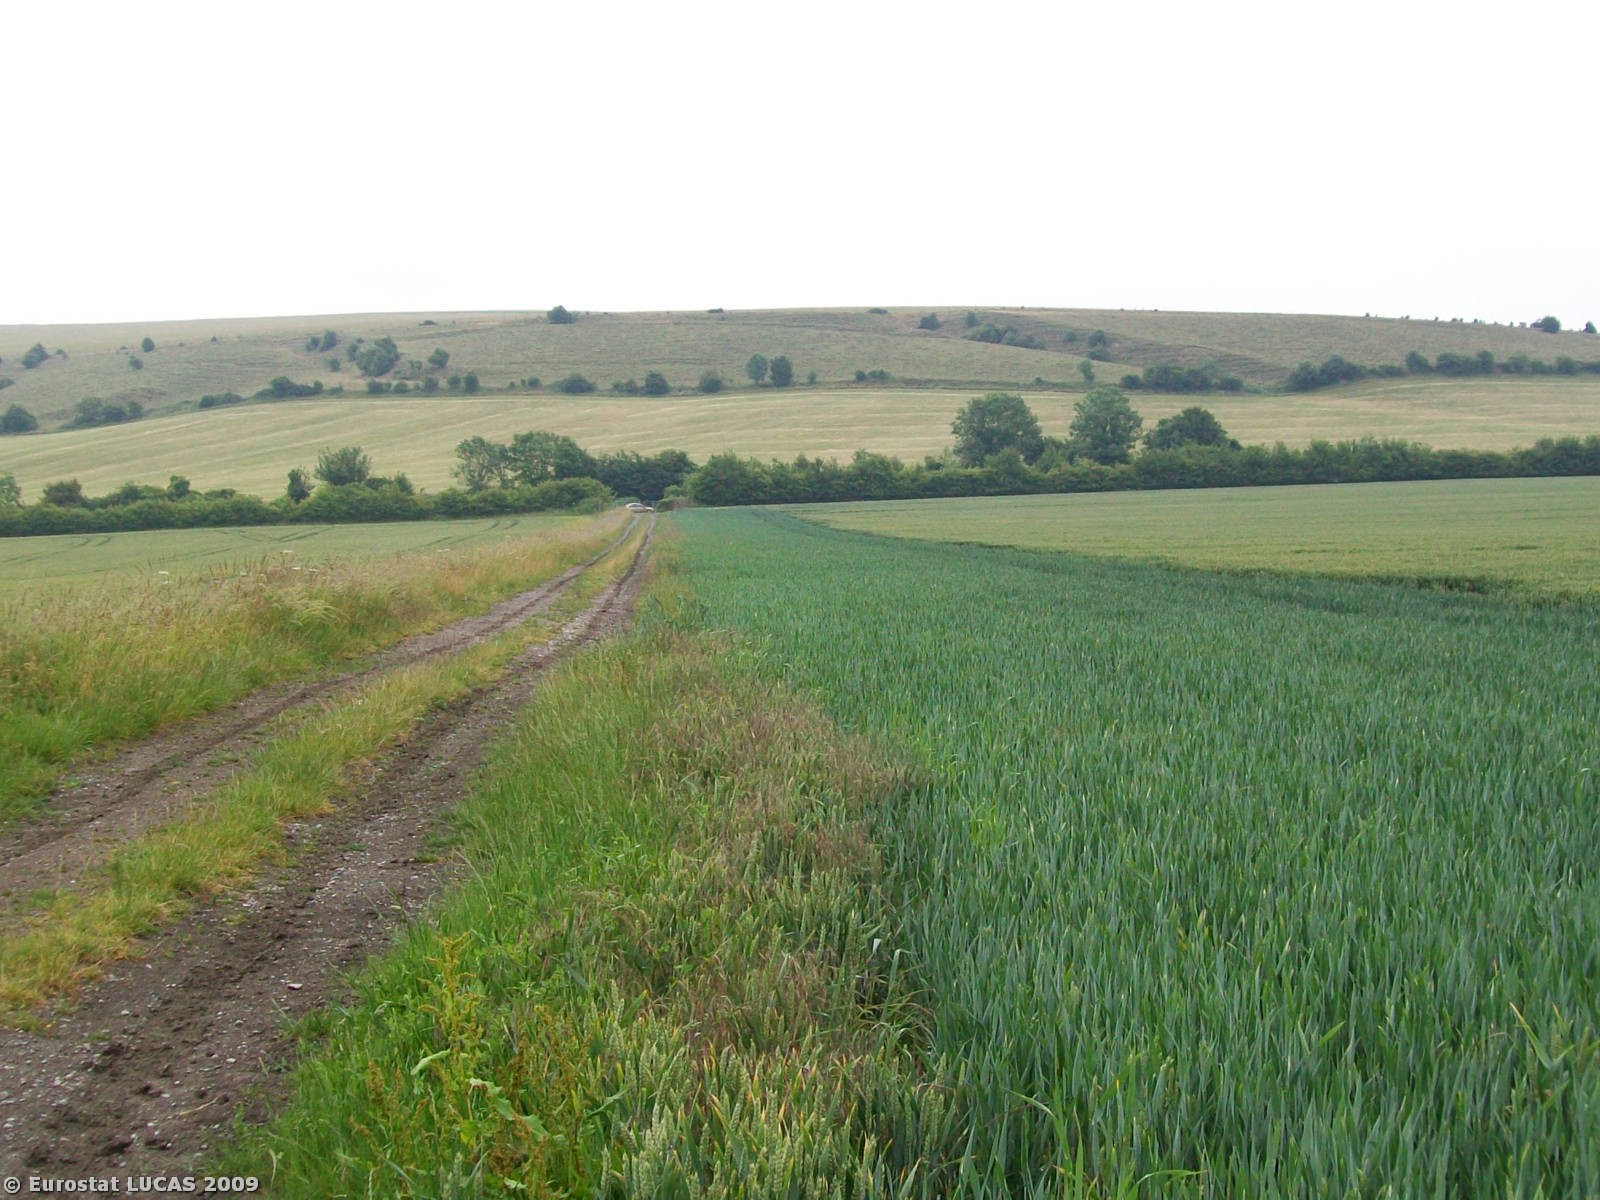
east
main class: Cropland
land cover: Common wheat
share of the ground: > 75 %
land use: Agriculture (excluding fallow land and kitchen gardens)
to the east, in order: Common wheat
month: June
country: GB
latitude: 51.2368
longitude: -2.1929
